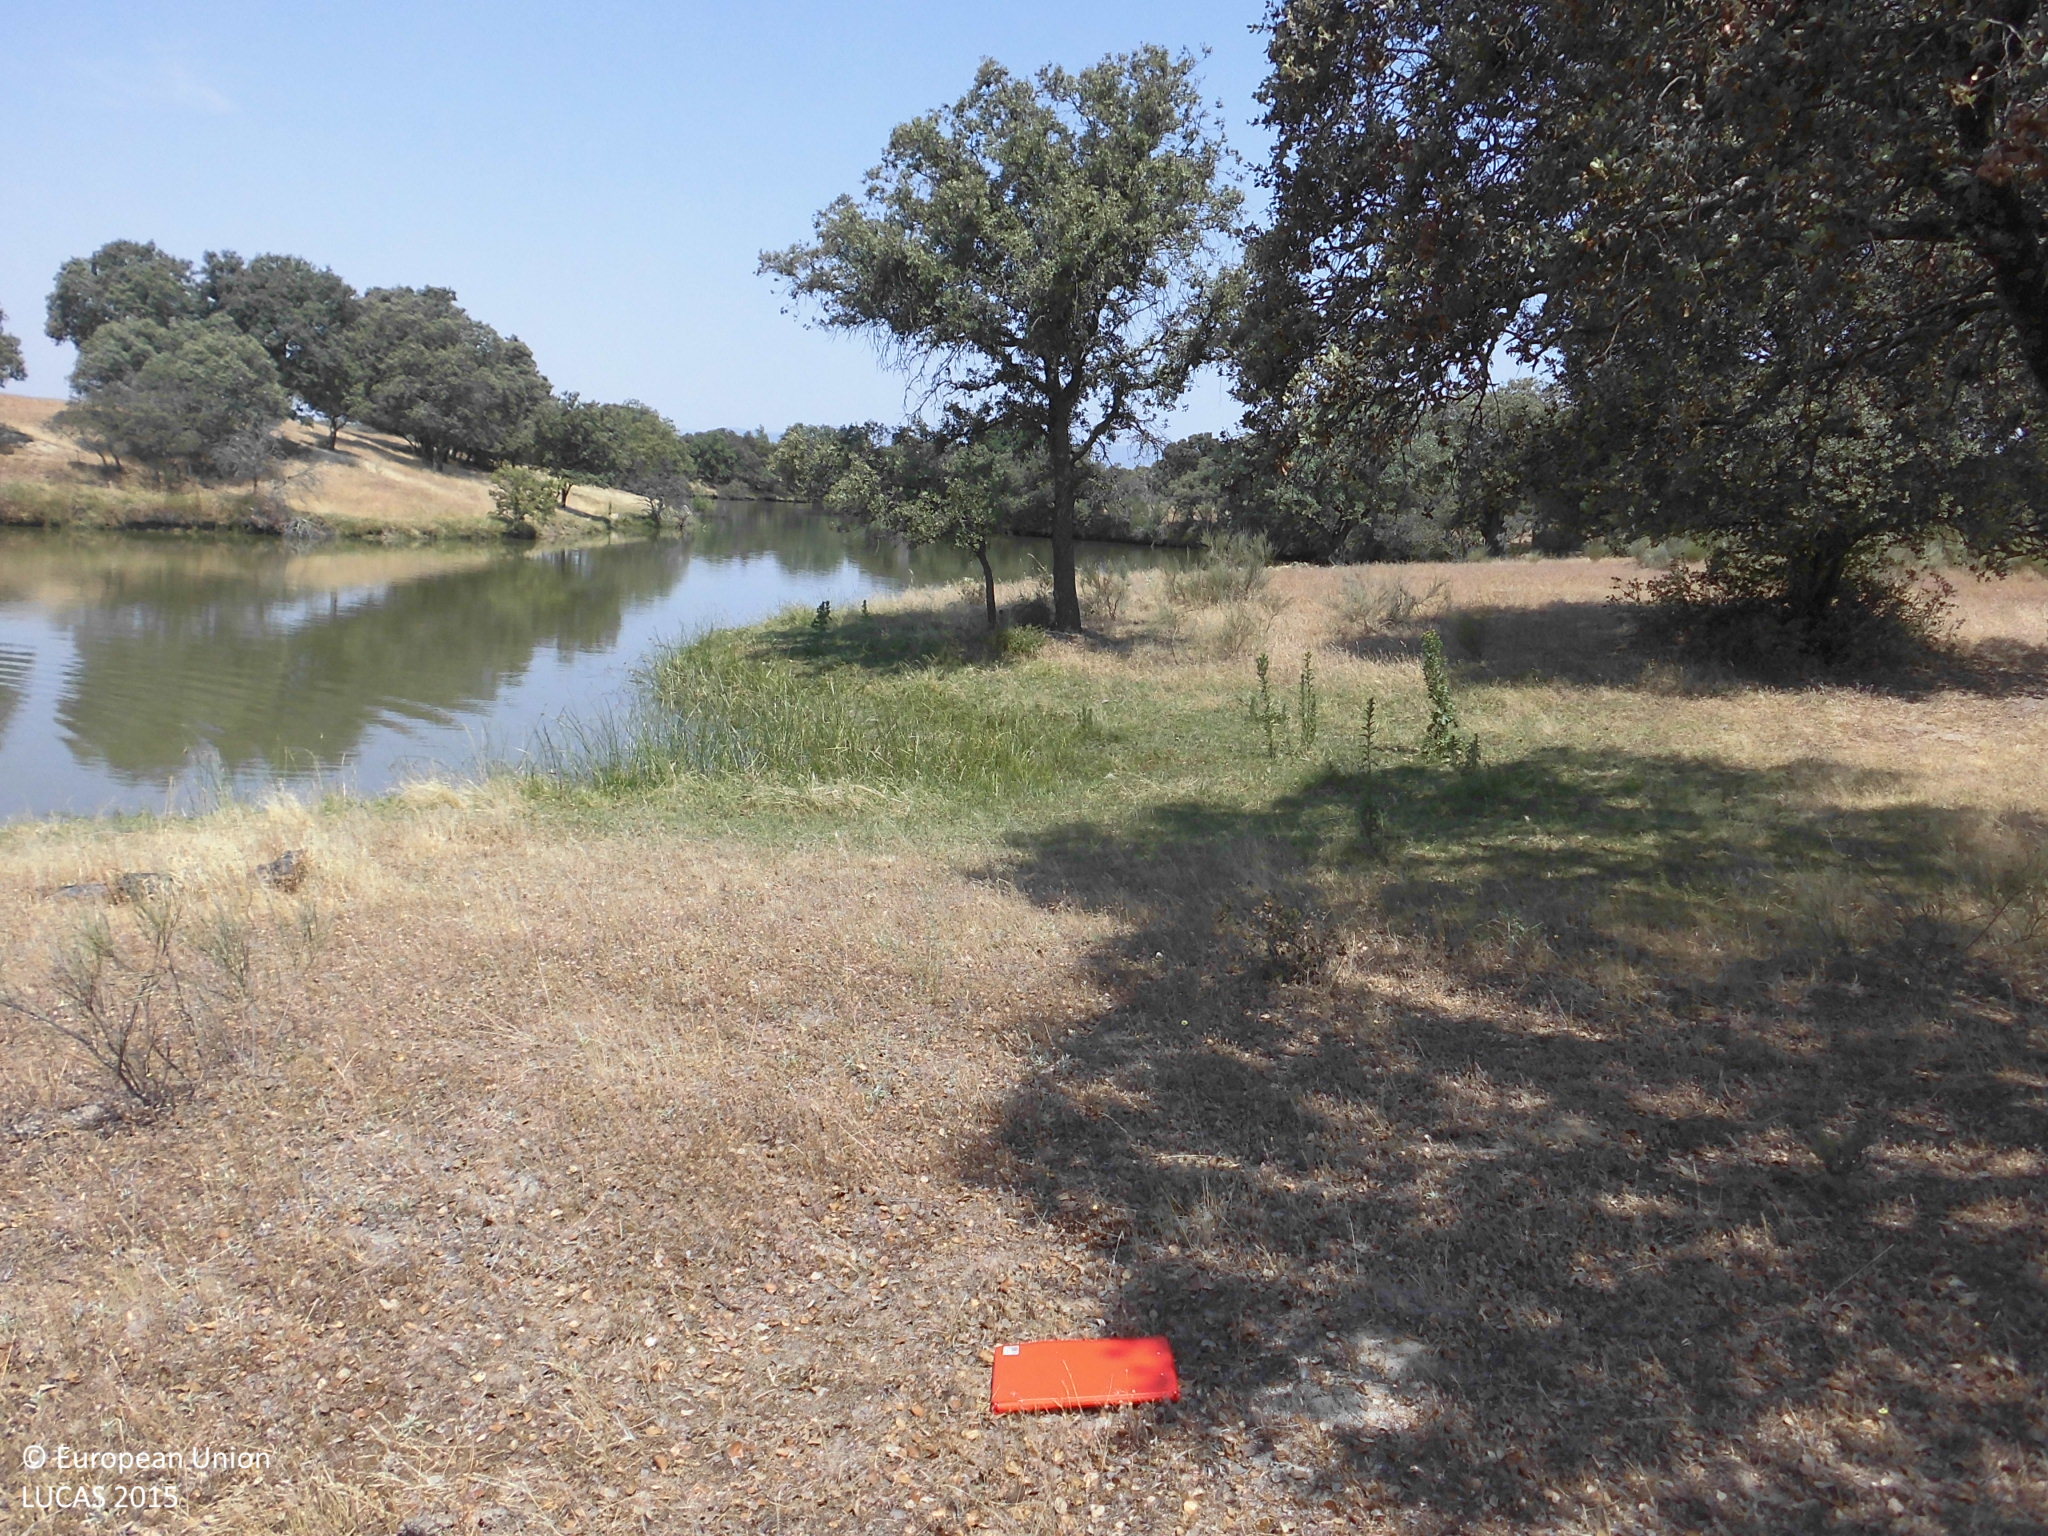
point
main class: Woodland
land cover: Broadleaved woodland
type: broadleaved evergreen forest
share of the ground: 10 - 25 %
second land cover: Grassland without tree/shrub cover
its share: > 75 %
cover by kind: herbaceous plants 80 %, broadleaved forest trees 15 %, consolidated bare surface 5 %
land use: Forestry
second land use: Agriculture (excluding fallow land and kitchen gardens)
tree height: > 5 m
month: June
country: ES
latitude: 39.9032
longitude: -5.6529
